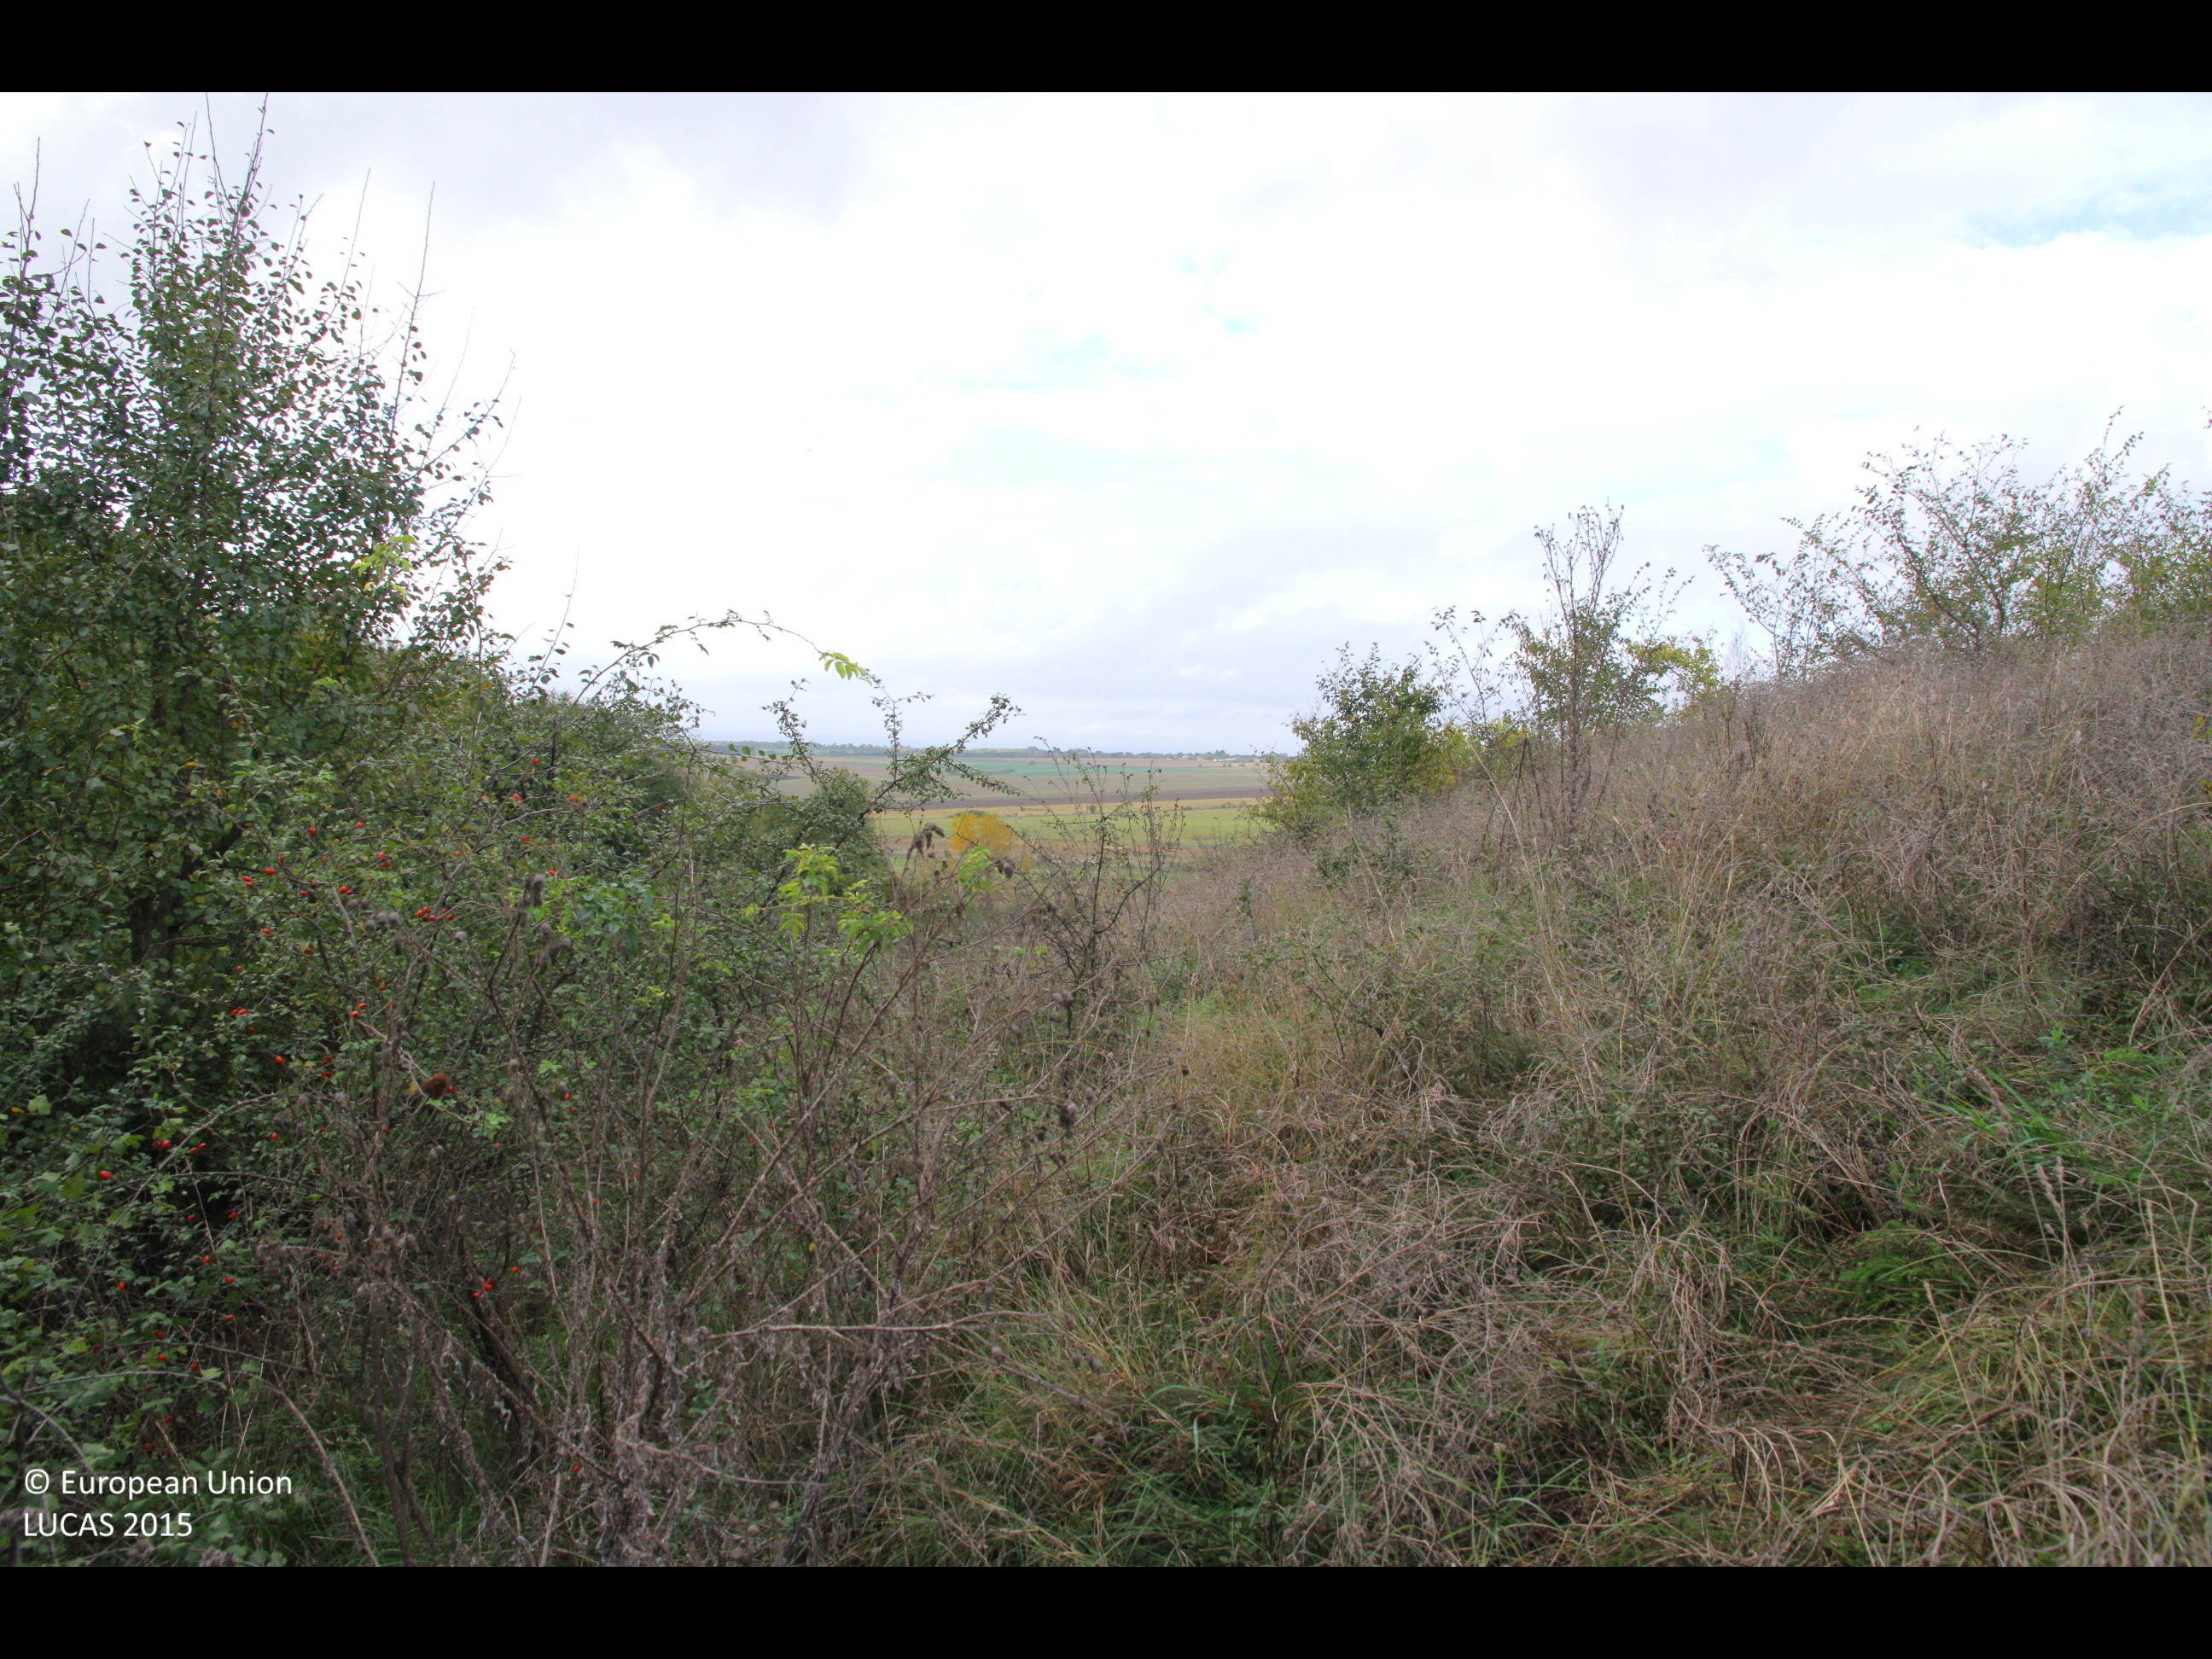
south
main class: Shrubland
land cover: Shrubland with sparse tree cover
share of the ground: > 75 %
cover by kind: shrubs 90 %, broadleaved forest trees 5 %, herbaceous plants 5 %
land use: Semi-natural and natural areas not in use
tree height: < 5 m
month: October
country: BG
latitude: 43.2008
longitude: 27.0619
